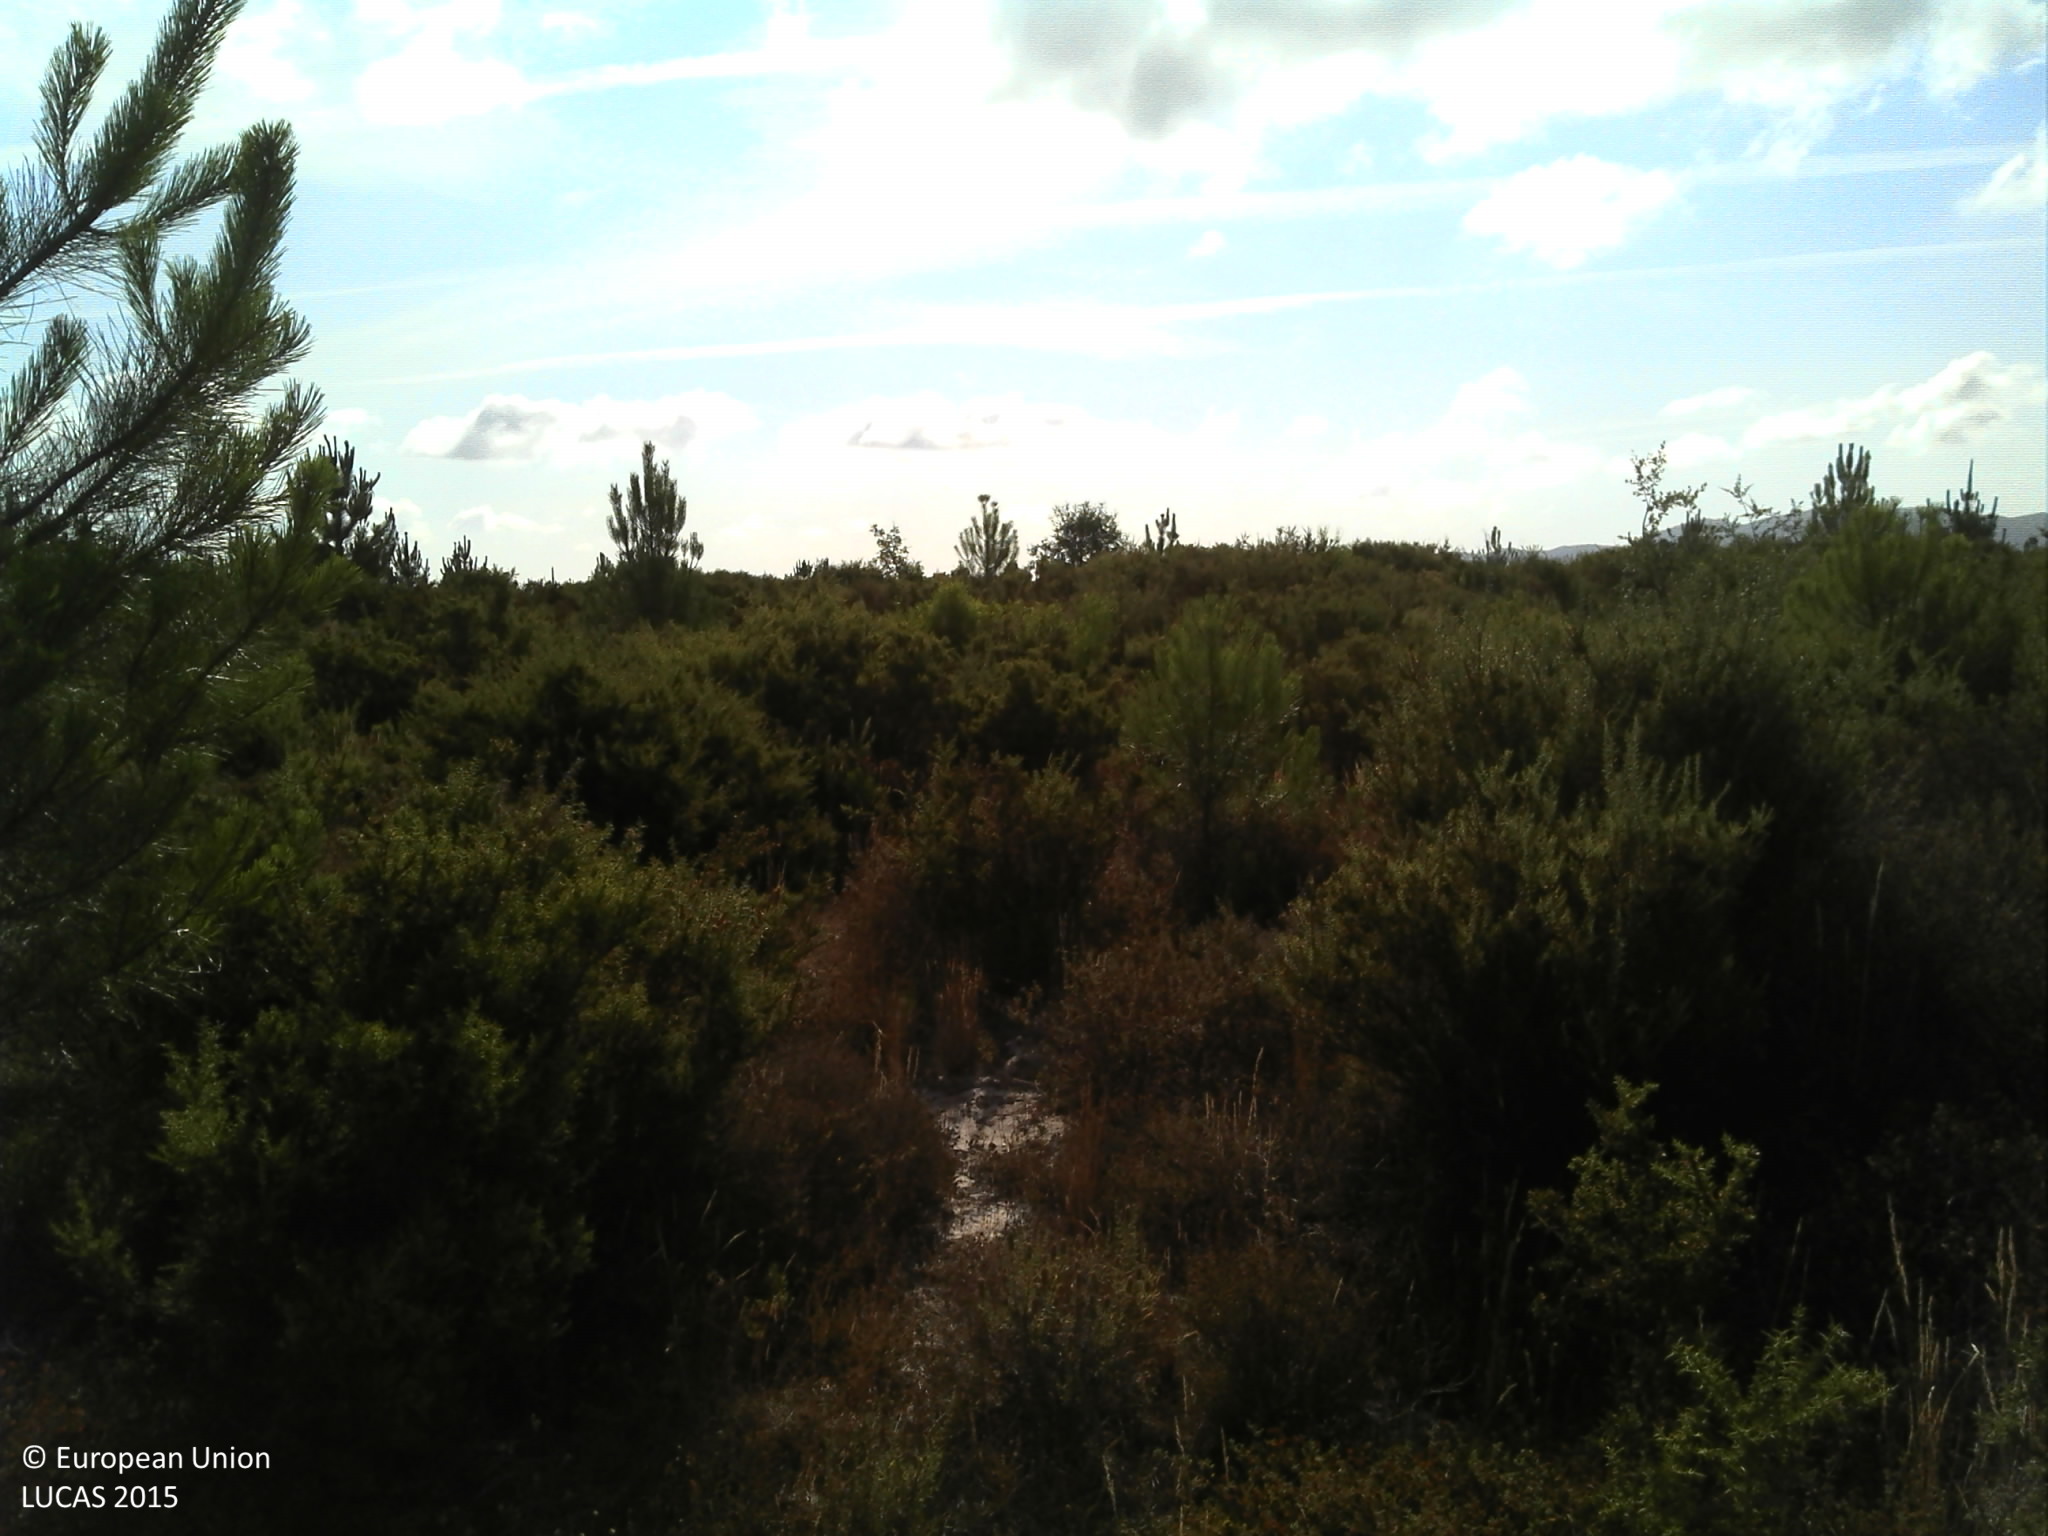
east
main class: Shrubland
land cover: Shrubland with sparse tree cover
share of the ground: 25 - 50 %
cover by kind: shrubs 40 %, unconsolidated bare surface 35 %, herbaceous plants 20 %, coniferous forest trees 5 %
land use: Semi-natural and natural areas not in use
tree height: < 5 m
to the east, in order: Shrubland with sparse tree cover; Tracks; Grassland without tree/shrub cover; Tracks; Grassland without tree/shrub cover; Grassland with sparse tree/shrub cover
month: July
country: PT
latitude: 38.5022
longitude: -9.0926
